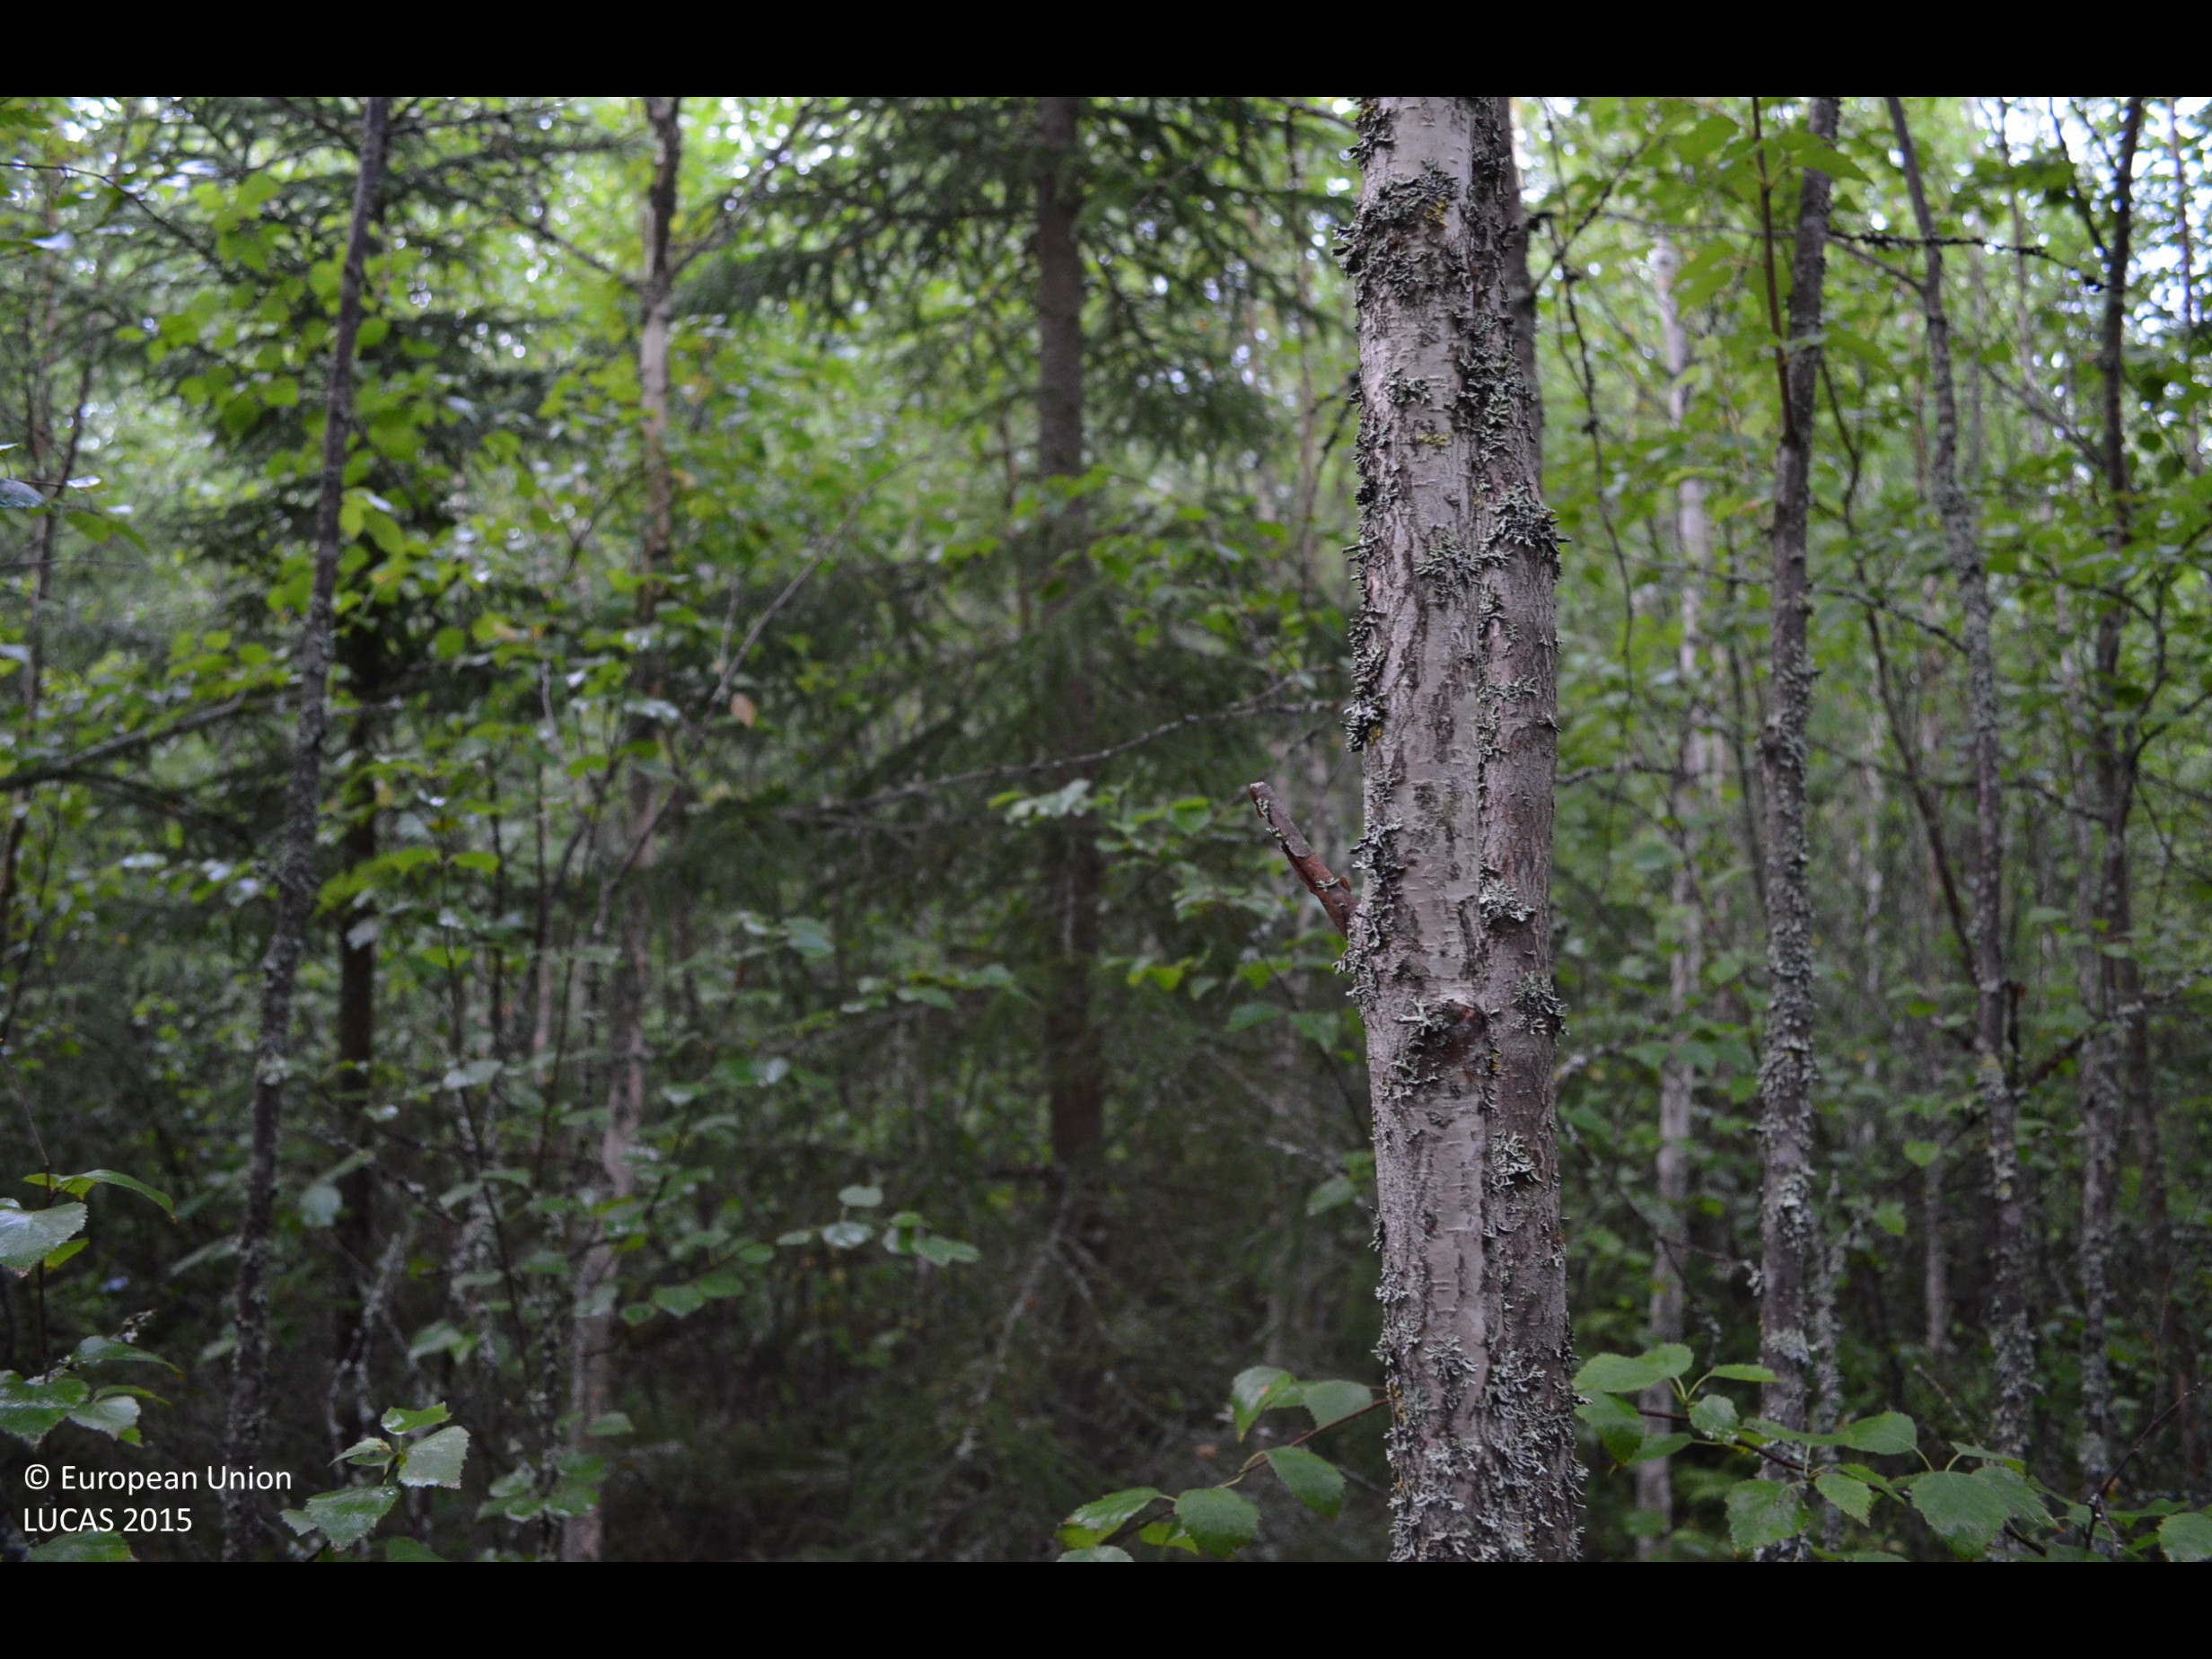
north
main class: Woodland
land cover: Broadleaved woodland
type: boreal forest
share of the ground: > 75 %
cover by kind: broadleaved forest trees 75 %, coniferous forest trees 20 %, herbaceous plants 5 %
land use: Forestry
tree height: > 5 m
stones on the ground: < 10 %
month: July
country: FI
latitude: 61.8988
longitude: 24.1907
